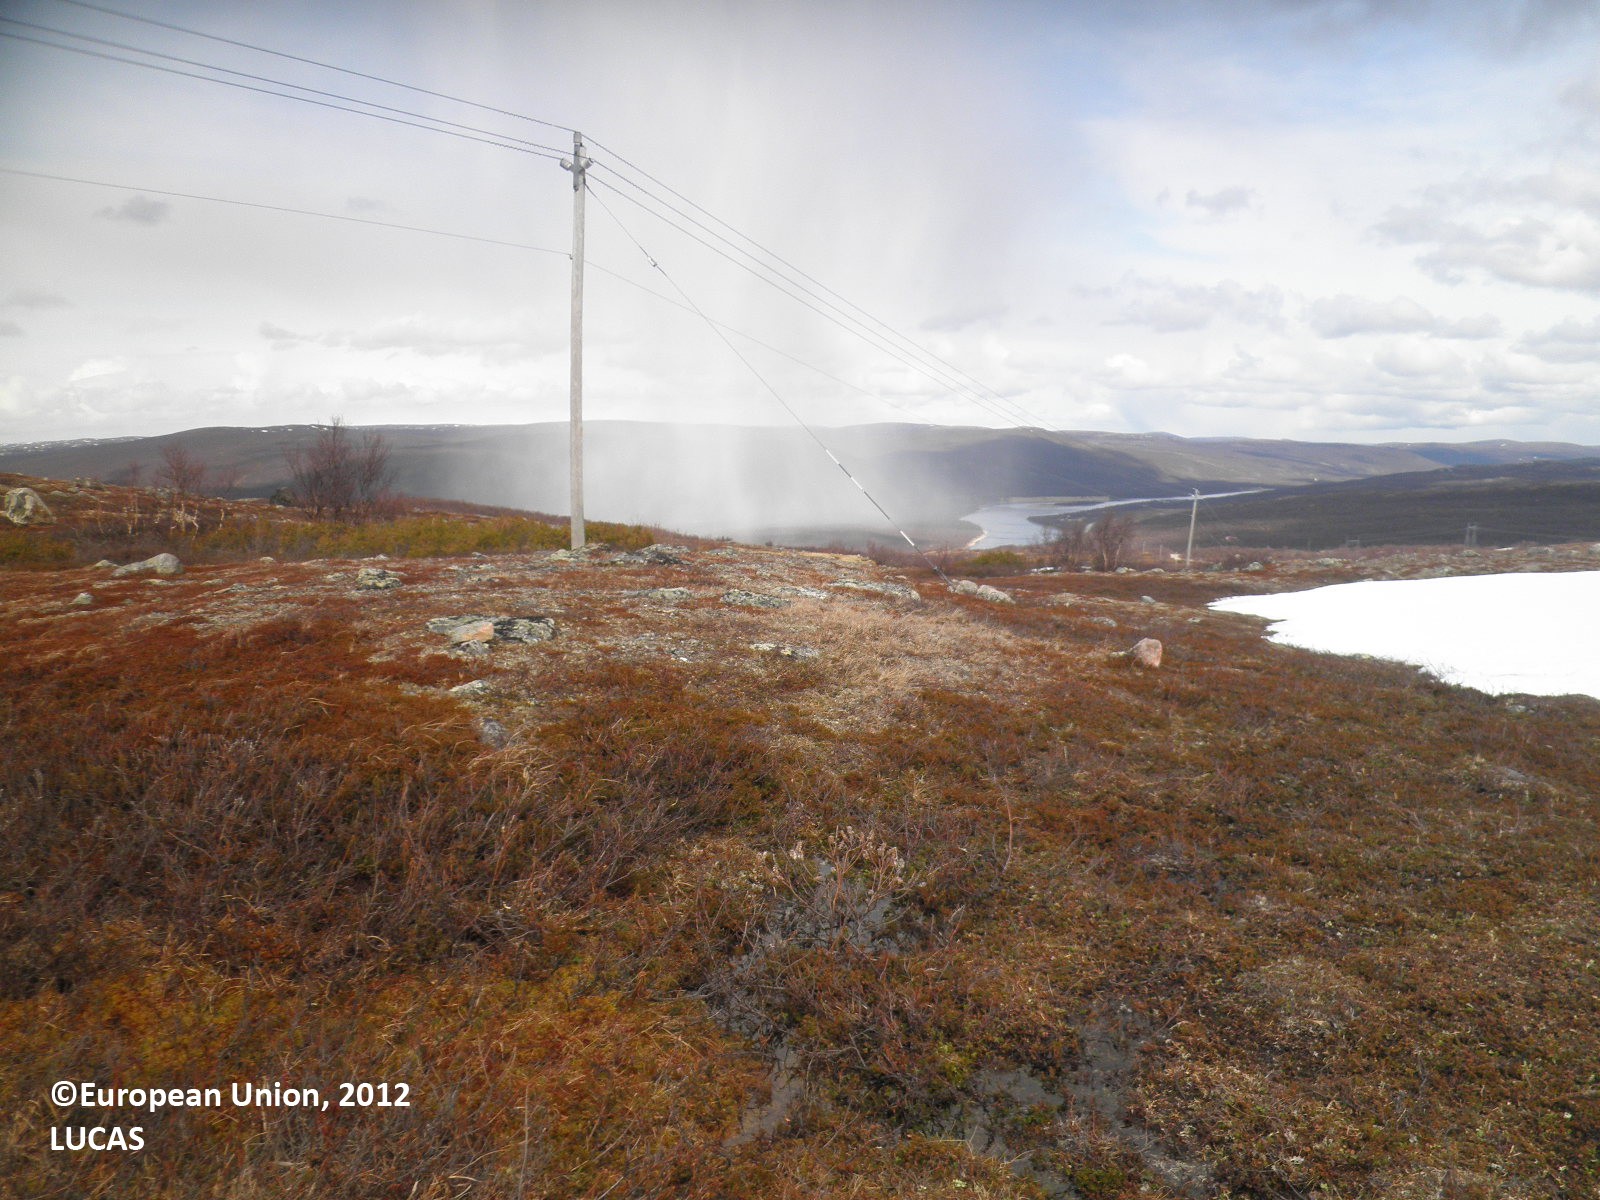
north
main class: Shrubland
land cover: Shrubland without tree cover
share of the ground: > 75 %
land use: Semi-natural and natural areas not in use
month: May
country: FI
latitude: 69.8993
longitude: 27.0673
